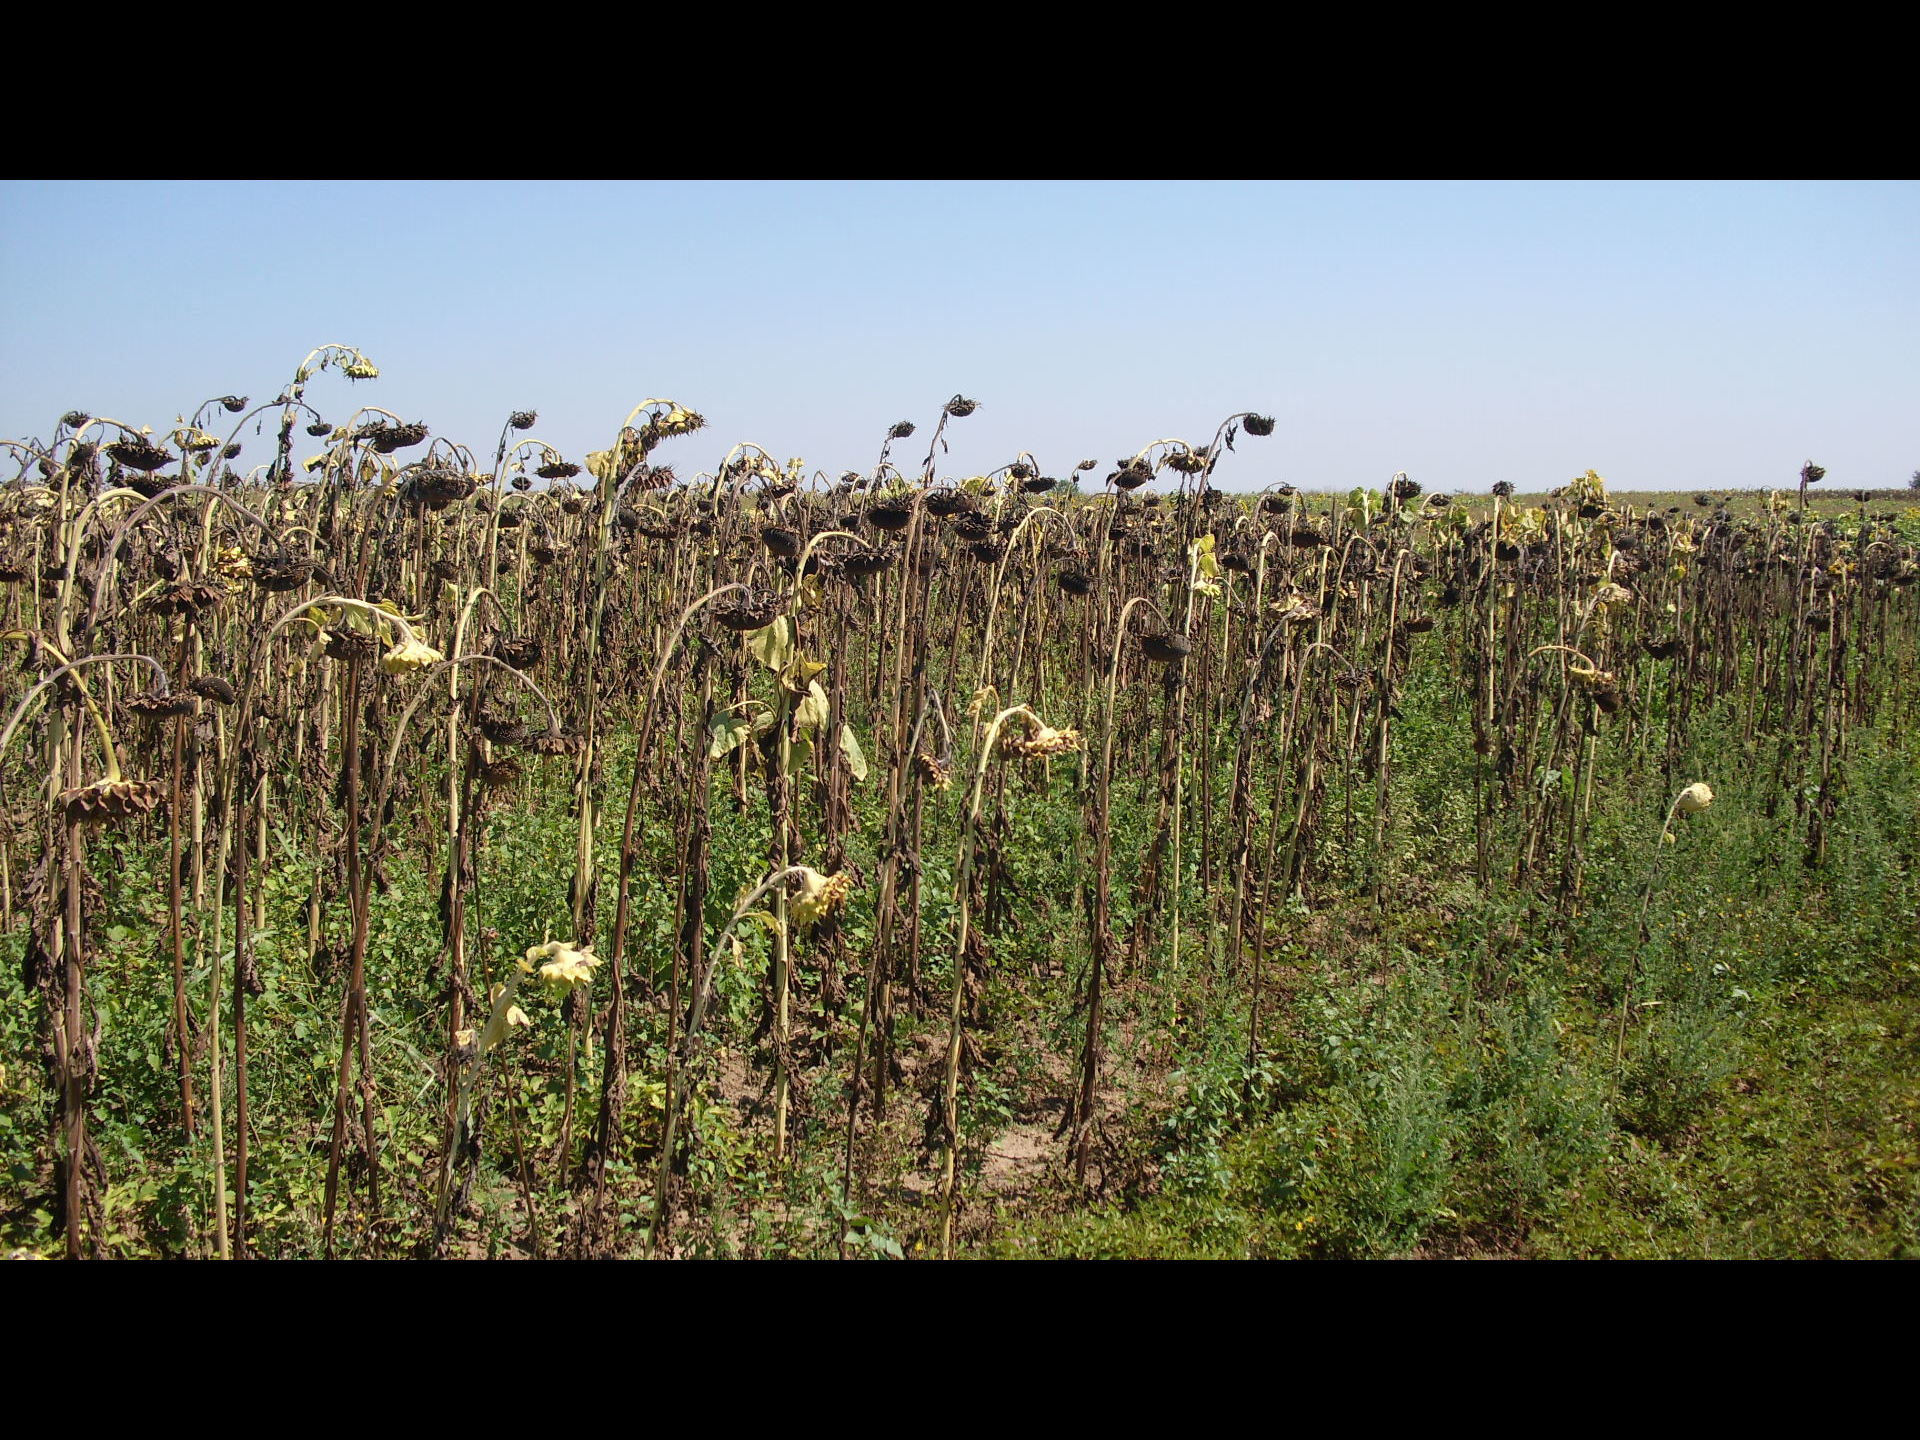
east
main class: Cropland
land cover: Sunflower
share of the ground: > 75 %
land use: Agriculture (excluding fallow land and kitchen gardens)
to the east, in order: Sunflower
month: August
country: BG
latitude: 44.1855
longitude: 22.7114
